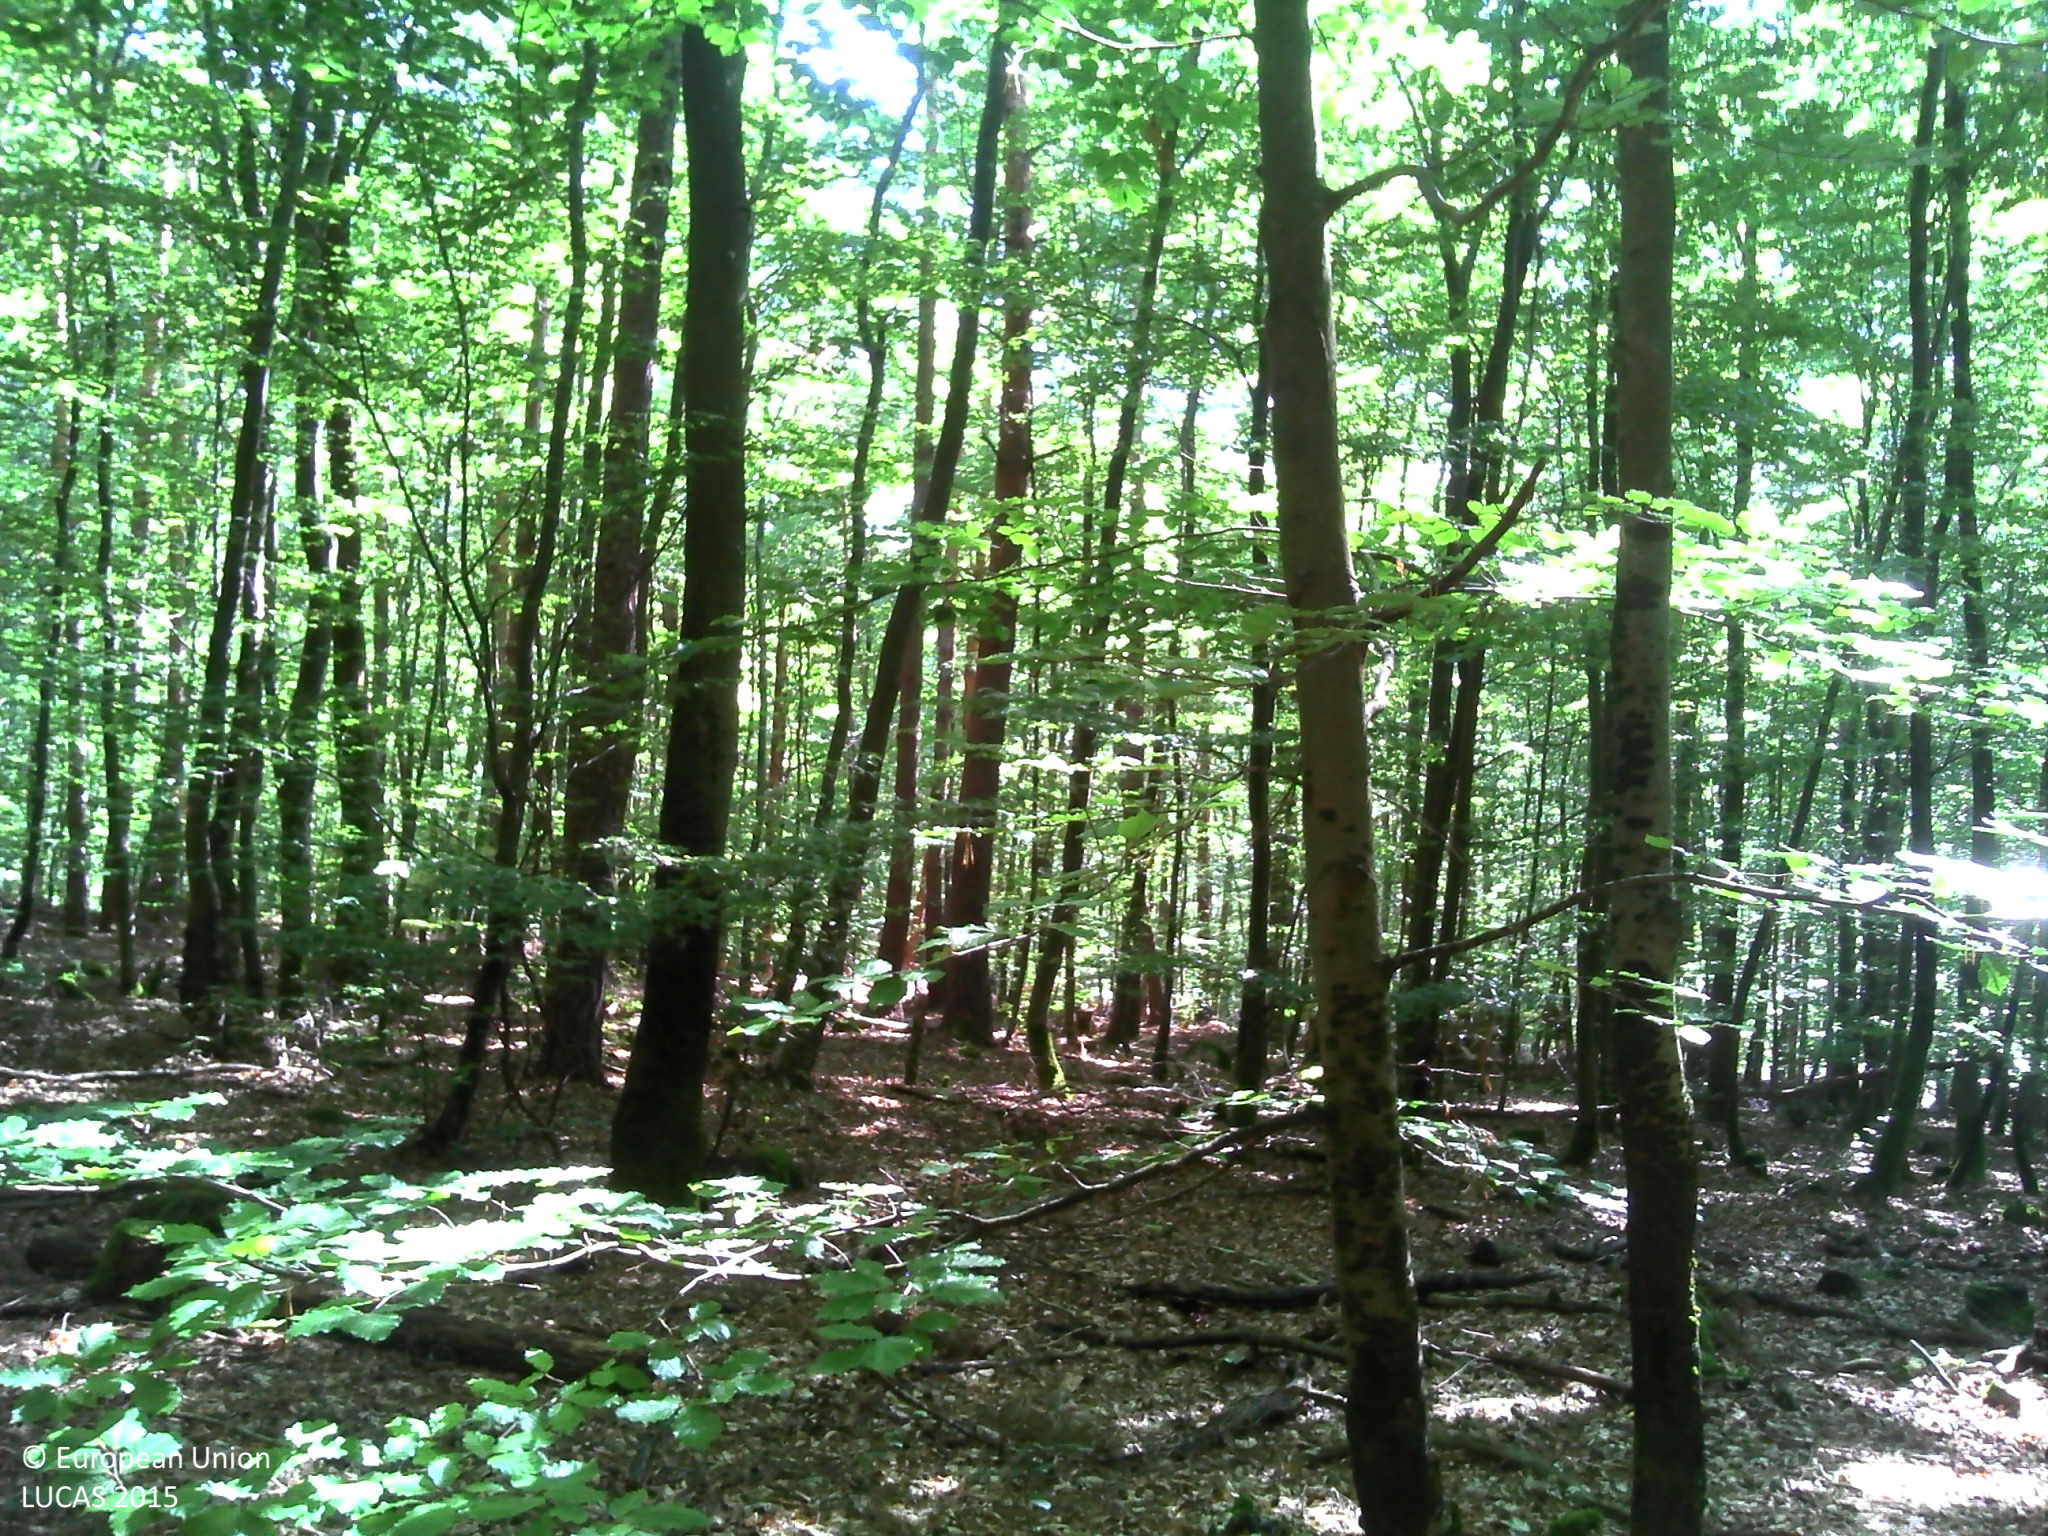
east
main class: Woodland
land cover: Pine dominated mixed woodland
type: hemiboreal forest and nemoral coniferous forest and mixed broadleaved-coniferous forest
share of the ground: > 75 %
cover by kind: broadleaved forest trees 65 %, coniferous forest trees 35 %
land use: Forestry
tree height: > 5 m
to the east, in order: Pine dominated mixed woodland; Tracks; Pine dominated mixed woodland; Tracks; Pine dominated mixed woodland; Tracks; Pine dominated mixed woodland
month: August
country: FR
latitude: 48.2810
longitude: 7.3193
